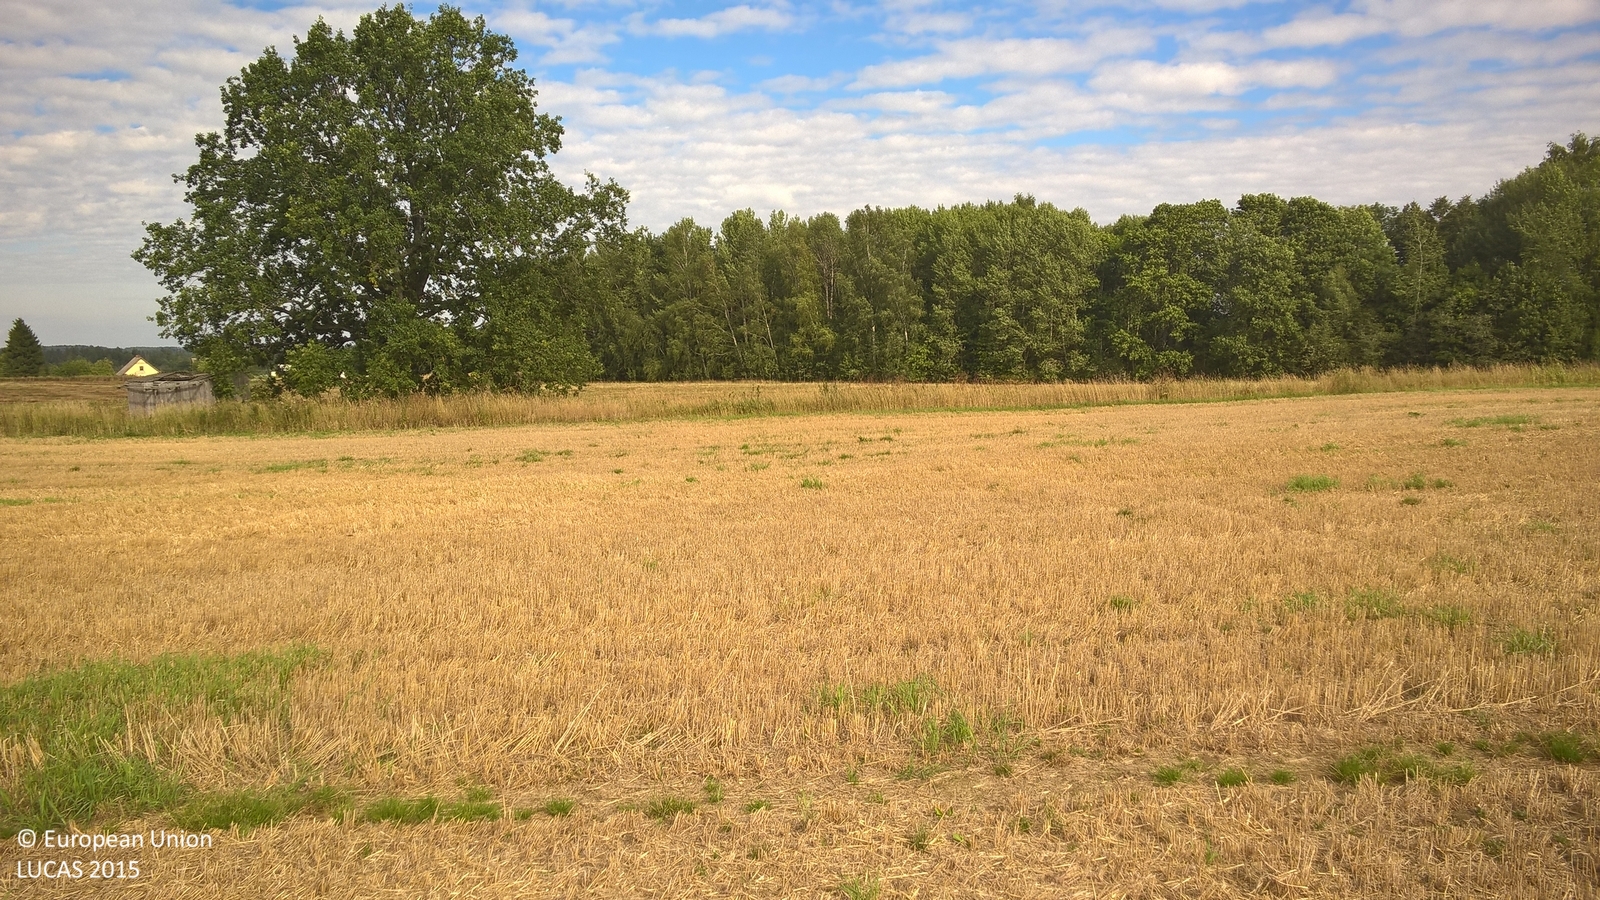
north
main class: Cropland
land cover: Barley
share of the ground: < 10 %
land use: Agriculture (excluding fallow land and kitchen gardens)
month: September
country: LV
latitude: 57.3326
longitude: 25.4809
